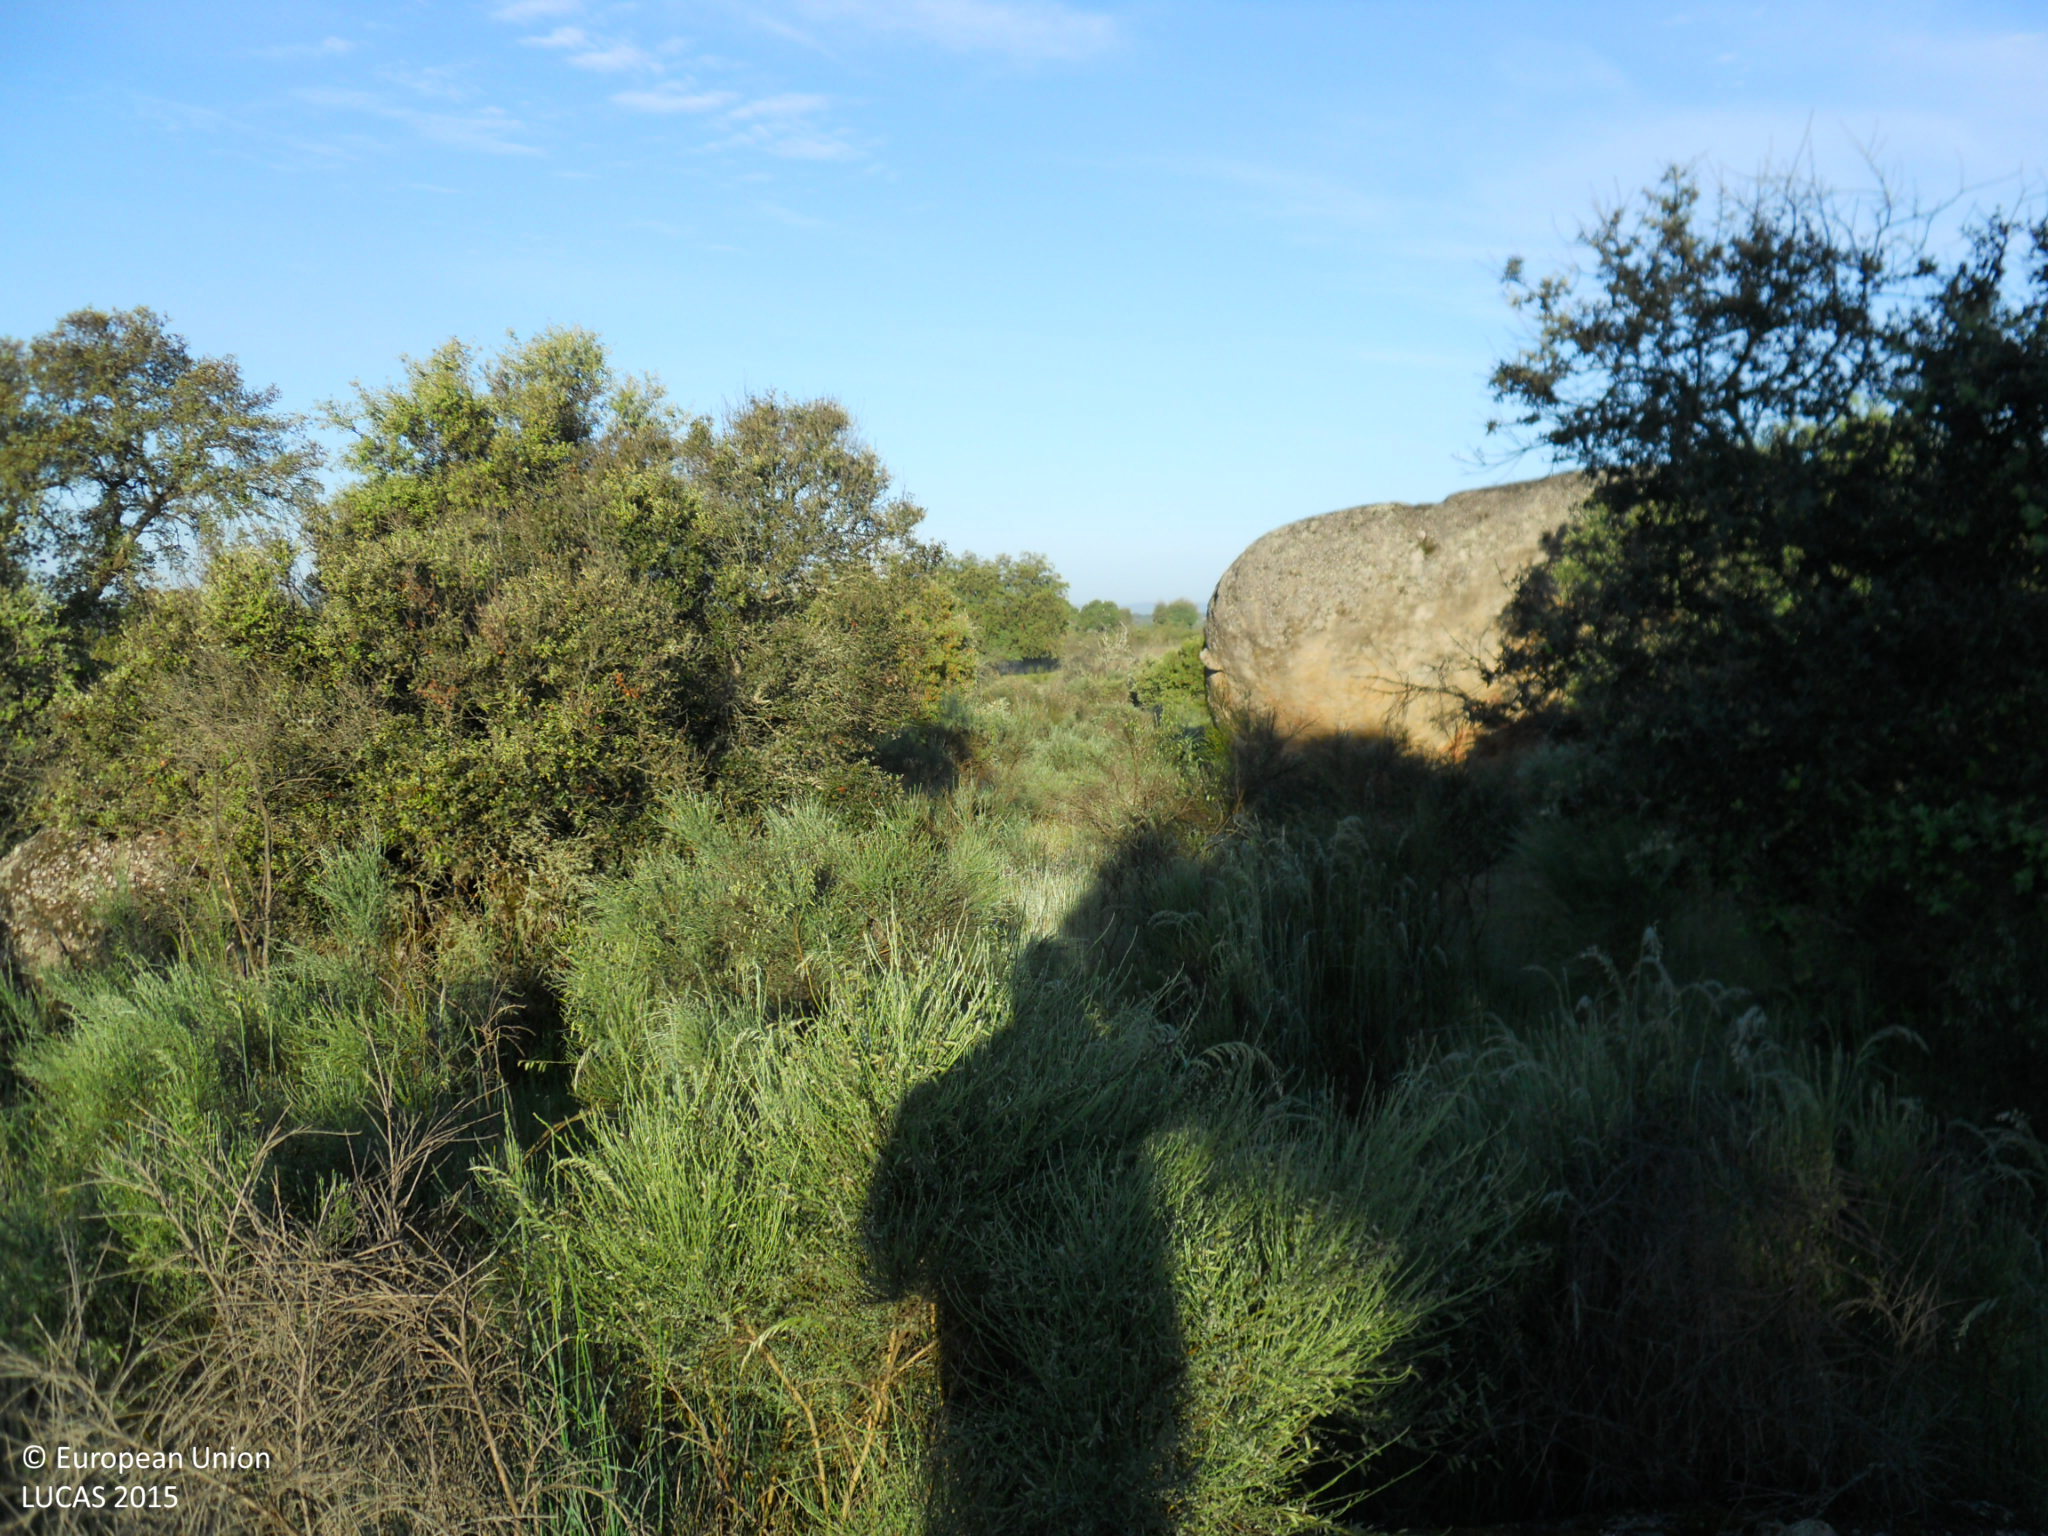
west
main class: Shrubland
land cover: Shrubland with sparse tree cover
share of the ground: > 75 %
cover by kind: shrubs 90 %, broadleaved forest trees 5 %, herbaceous plants 5 %
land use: Agriculture (excluding fallow land and kitchen gardens)
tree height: > 5 m
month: April
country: ES
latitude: 39.4055
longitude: -6.4310
